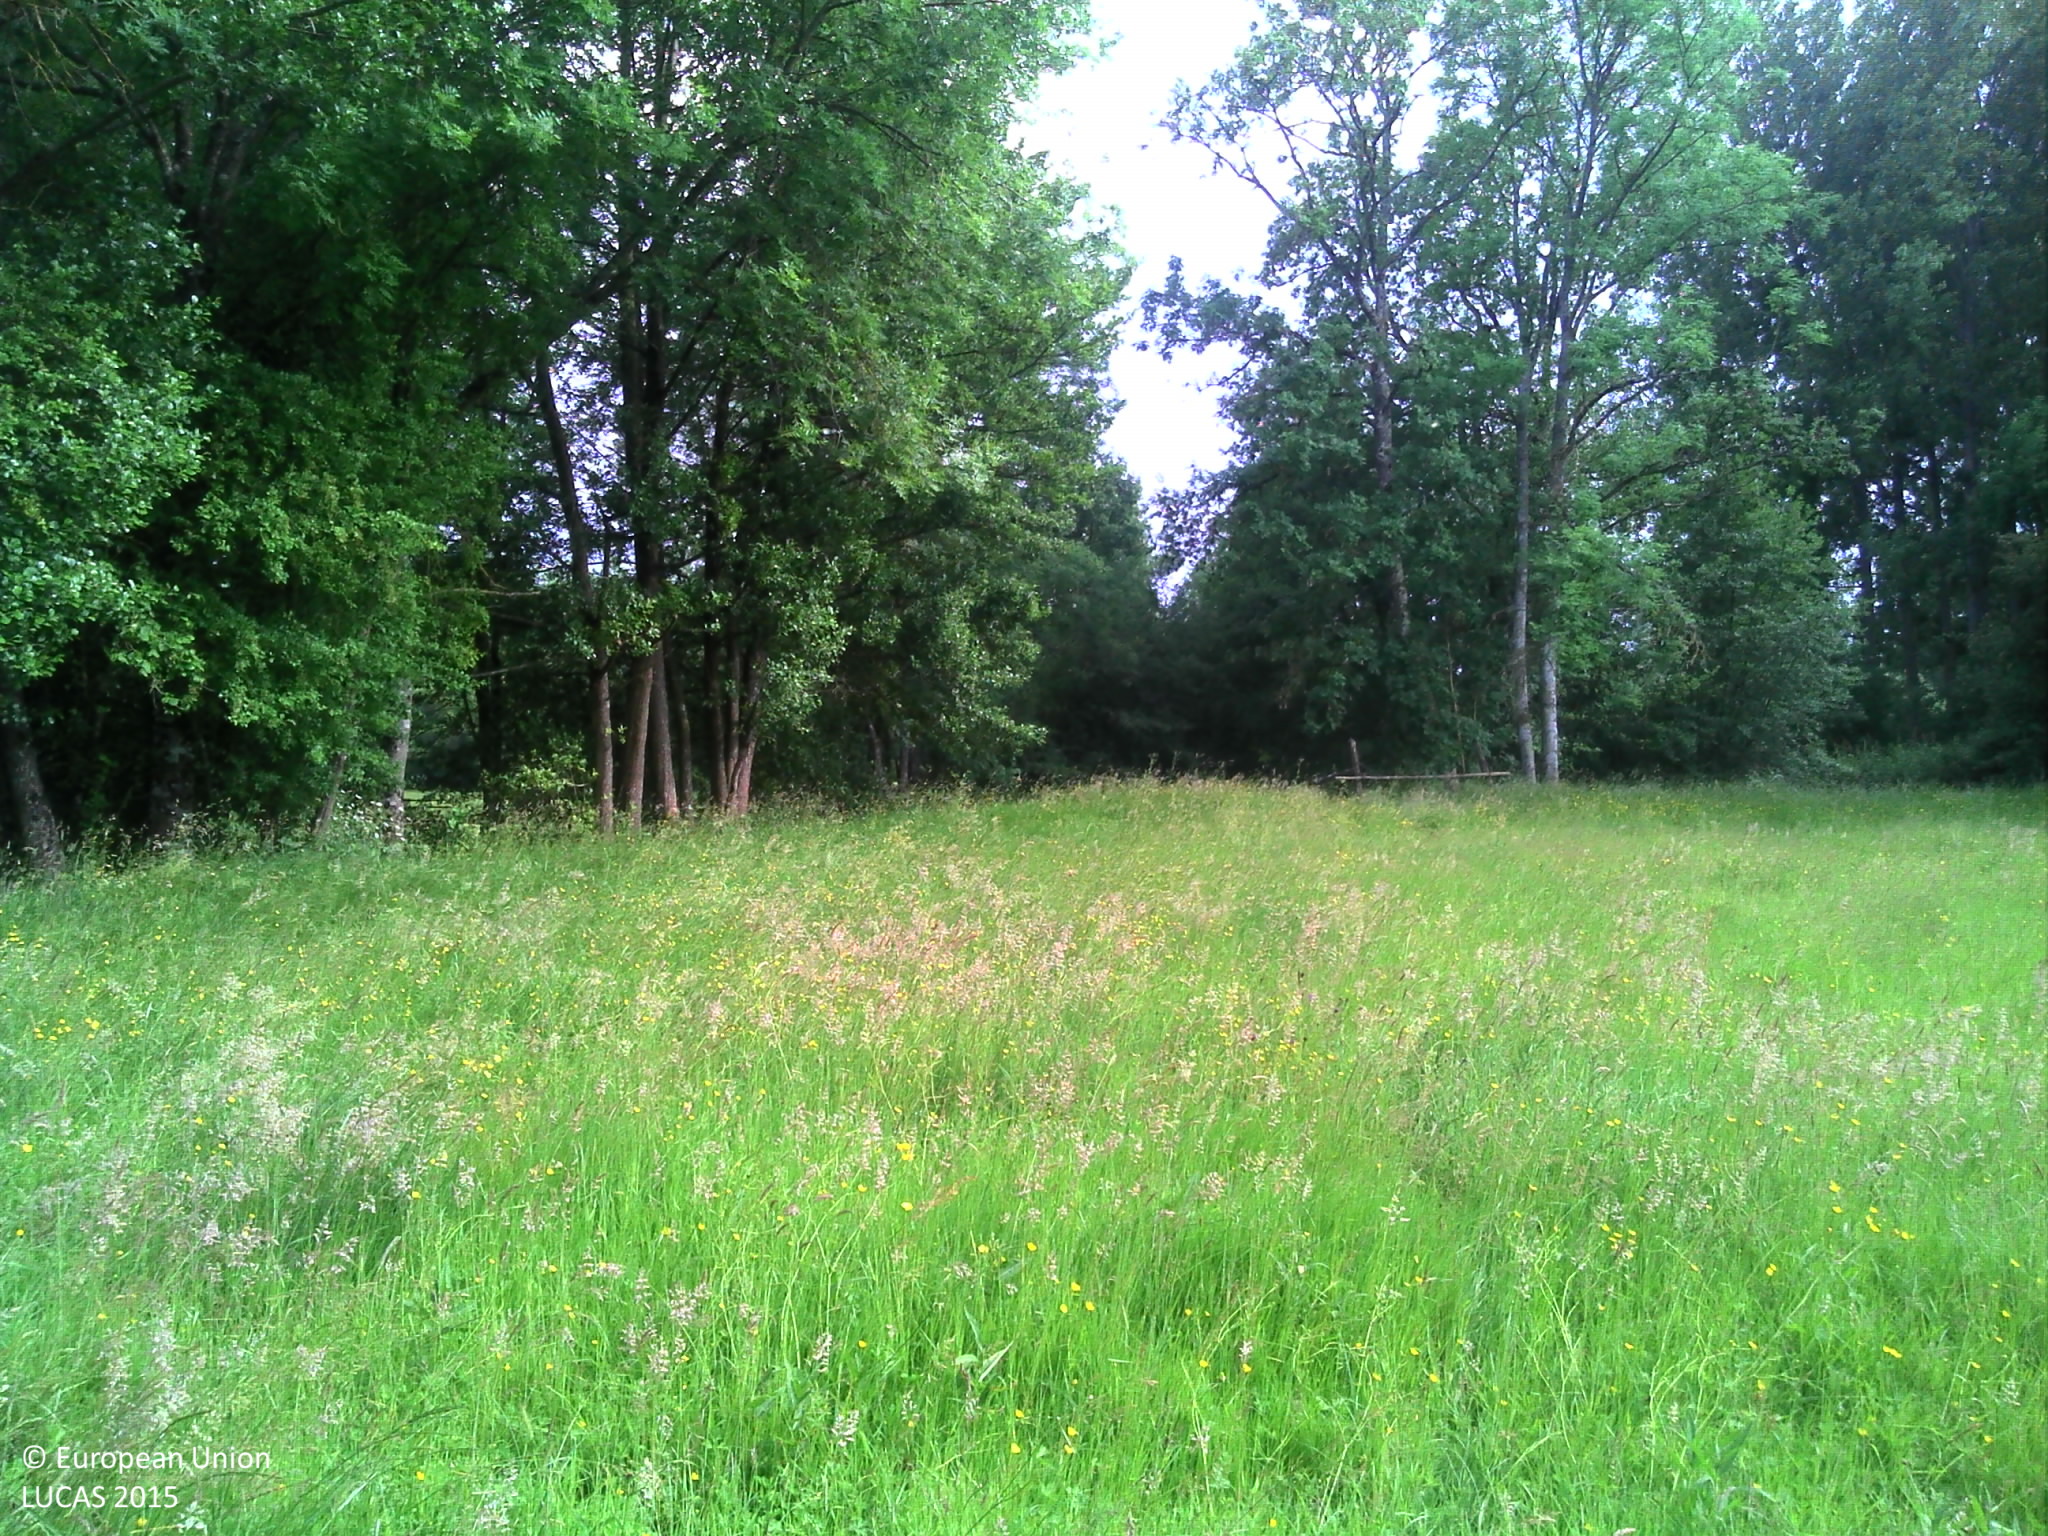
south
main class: Grassland
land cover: Grassland without tree/shrub cover
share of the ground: > 75 %
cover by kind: herbaceous plants 100 %
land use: Agriculture (excluding fallow land and kitchen gardens)
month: June
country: FR
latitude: 48.4763
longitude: 0.2194
